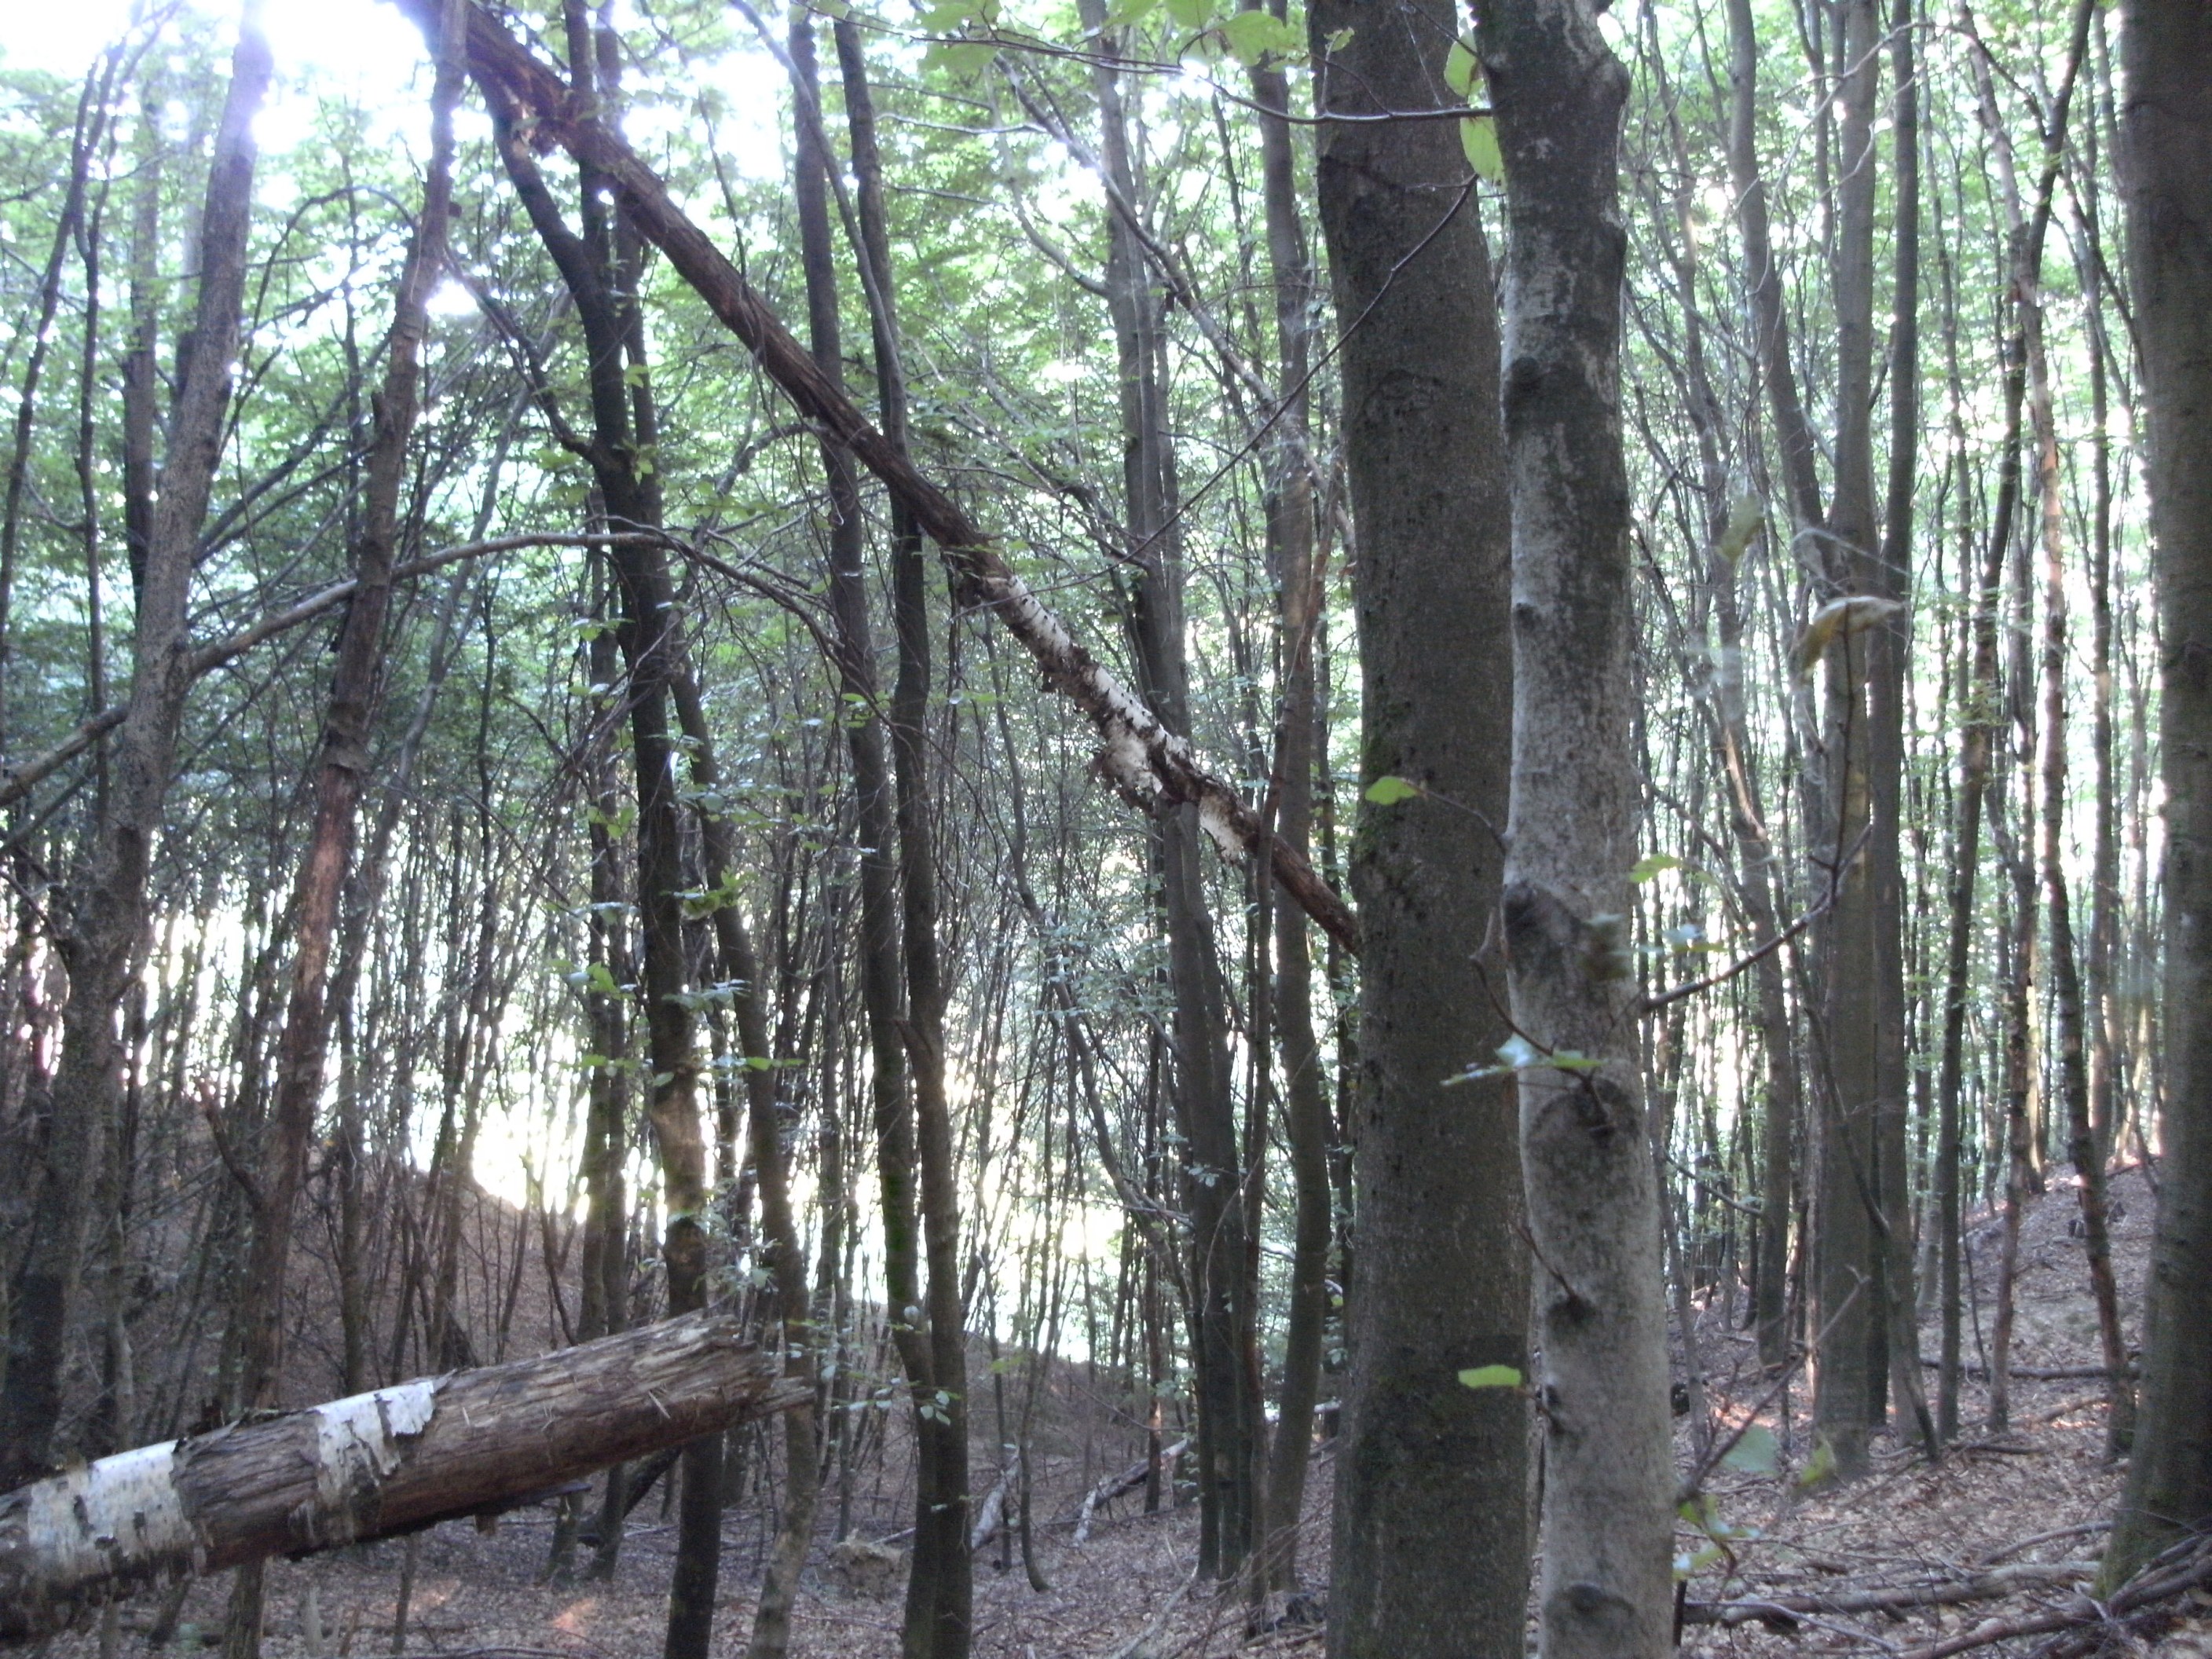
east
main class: Woodland
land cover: Broadleaved woodland
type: mountainous beech forest
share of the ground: > 75 %
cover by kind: broadleaved forest trees 100 %
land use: Forestry
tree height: > 5 m
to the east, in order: Broadleaved woodland; Spruce dominated mixed woodland; Broadleaved woodland; Spontaneously vegetated surfaces; Rivers and streams; Spontaneously vegetated surfaces; Tracks; Spruce dominated mixed woodland; Broadleaved woodland; Tracks
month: July
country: AT
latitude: 48.3050
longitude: 14.2200
